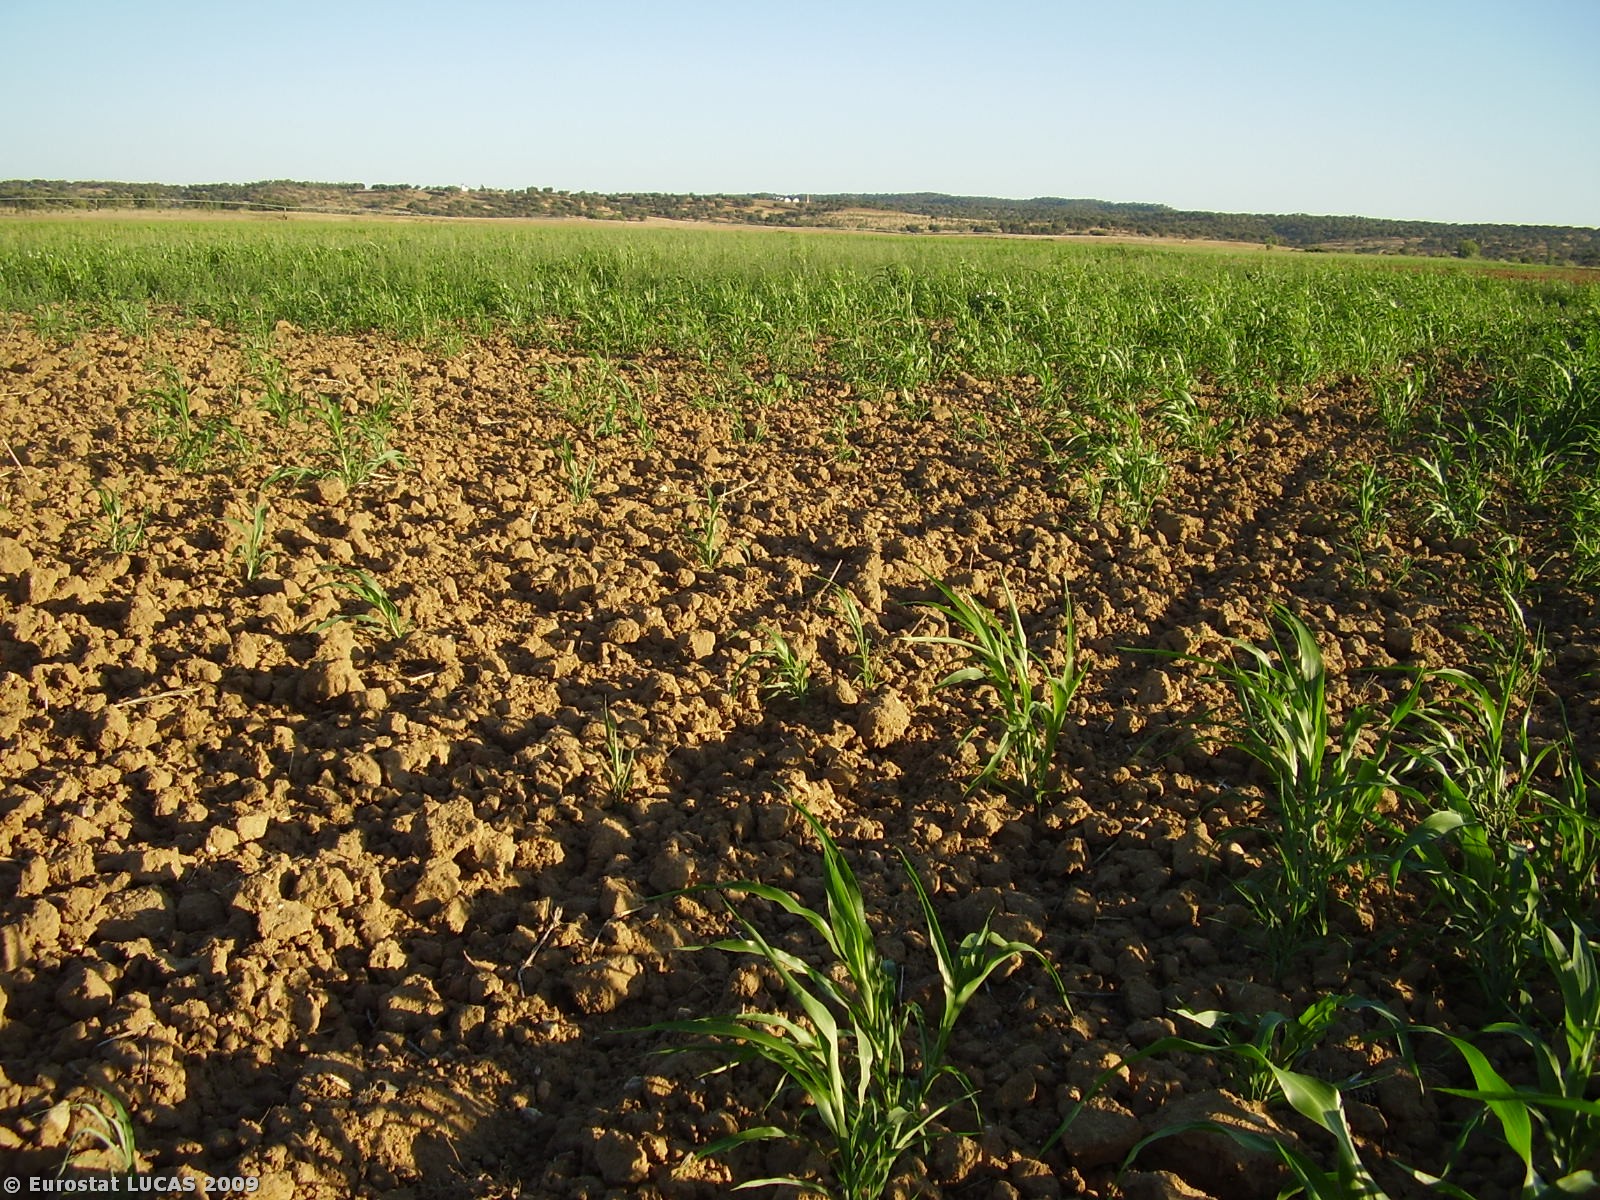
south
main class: Cropland
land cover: Maize
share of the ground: > 75 %
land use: Agriculture (excluding fallow land and kitchen gardens)
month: July
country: PT
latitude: 38.9537
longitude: -8.0159
